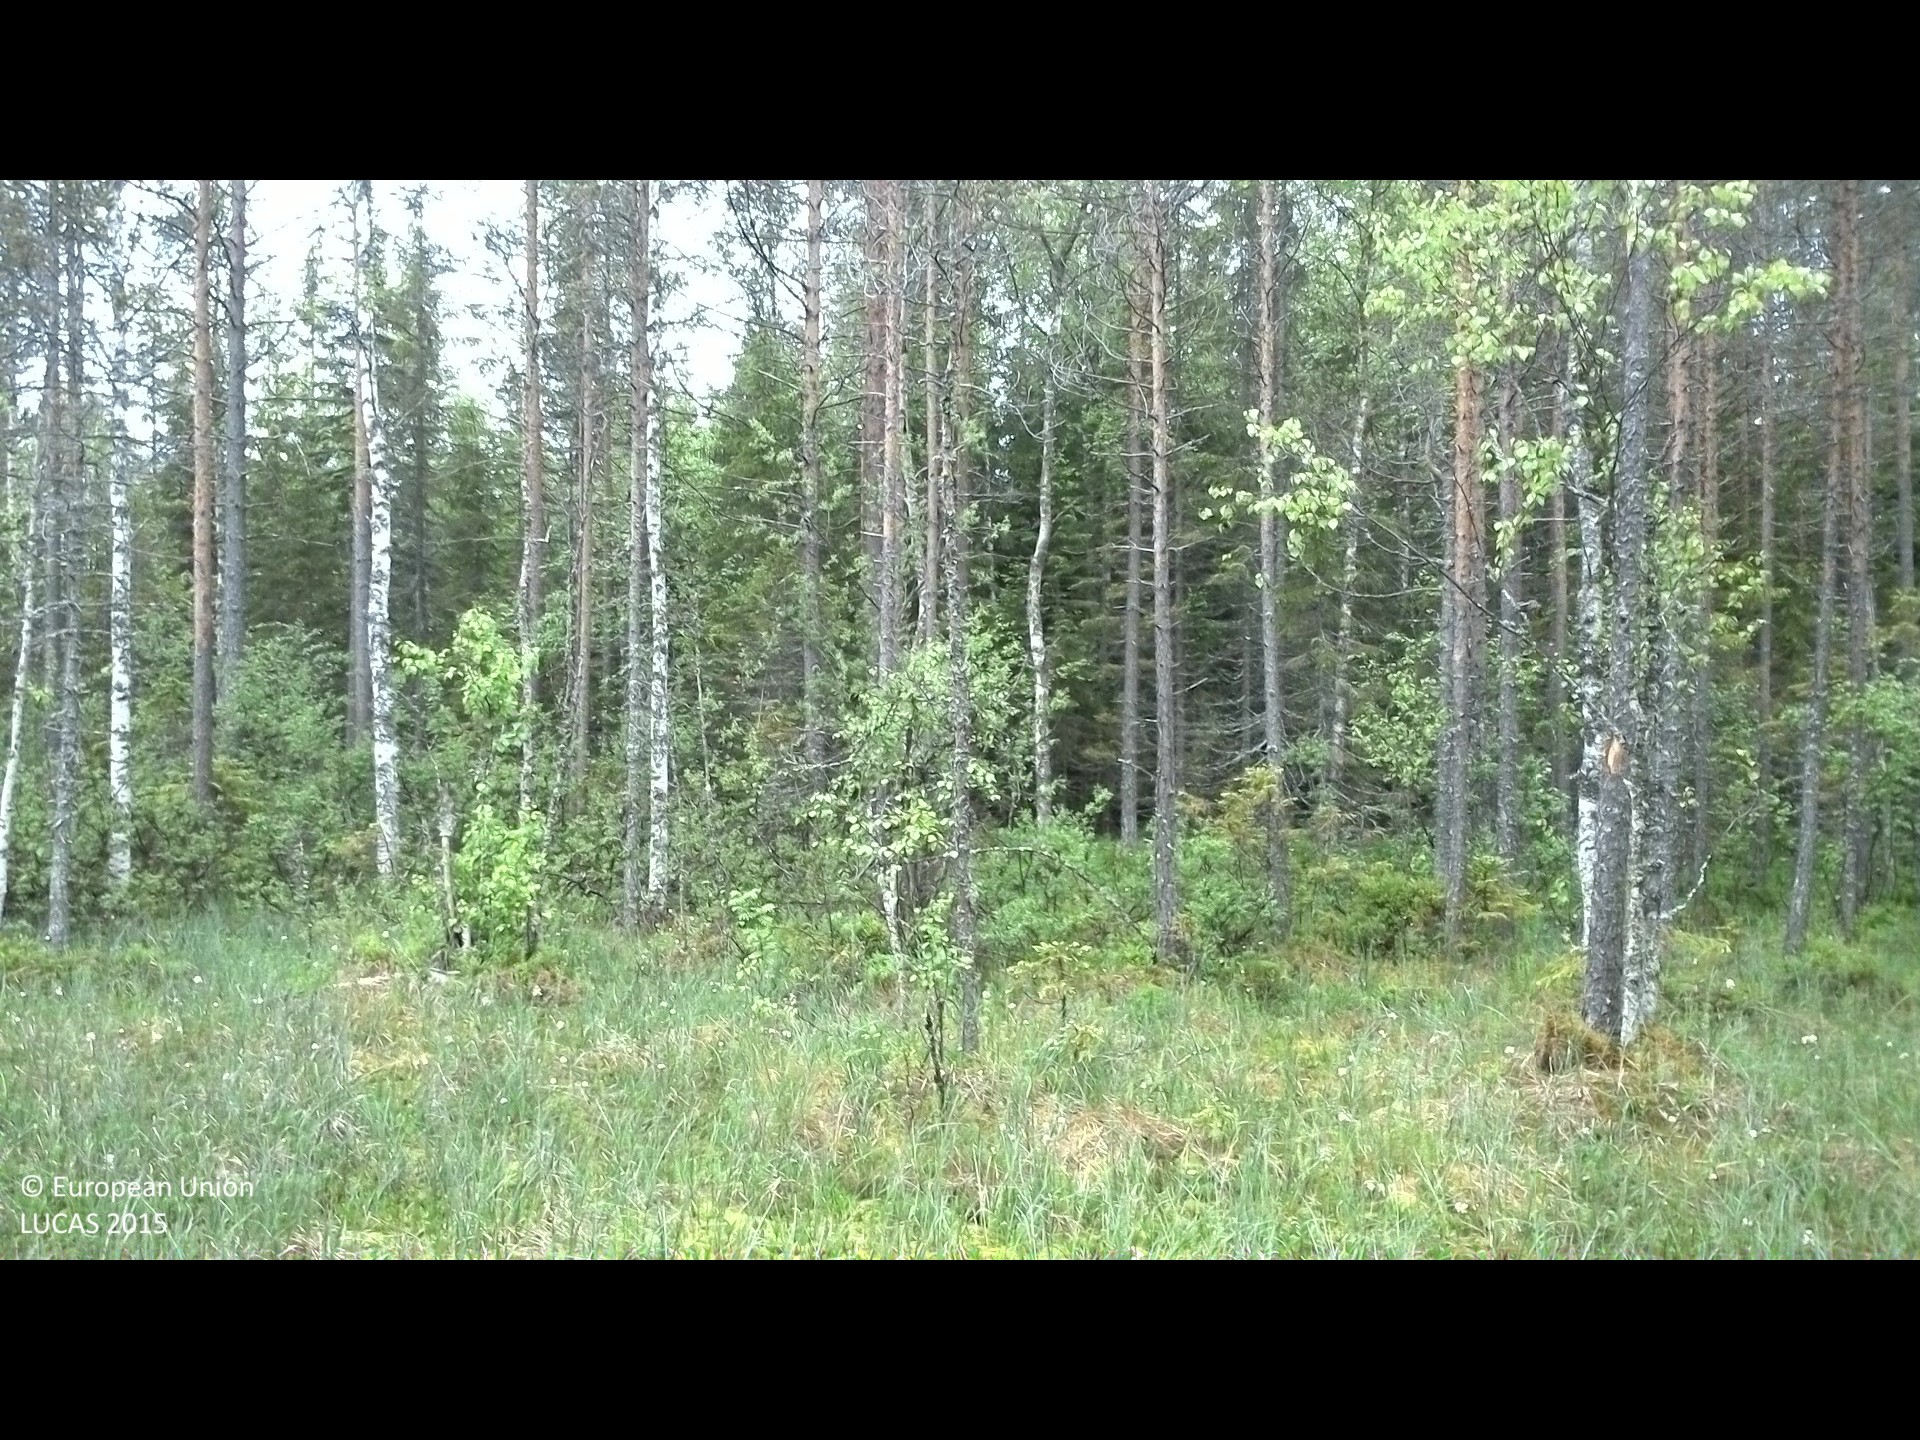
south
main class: Woodland
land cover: Pine dominated mixed woodland
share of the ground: 10 - 25 %
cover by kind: lichens and mosses 50 %, shrubs 25 %, coniferous forest trees 10 %, herbaceous plants 10 %, broadleaved forest trees 5 %
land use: Forestry
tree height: > 5 m
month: June
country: SE
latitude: 61.9186
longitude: 17.1239
